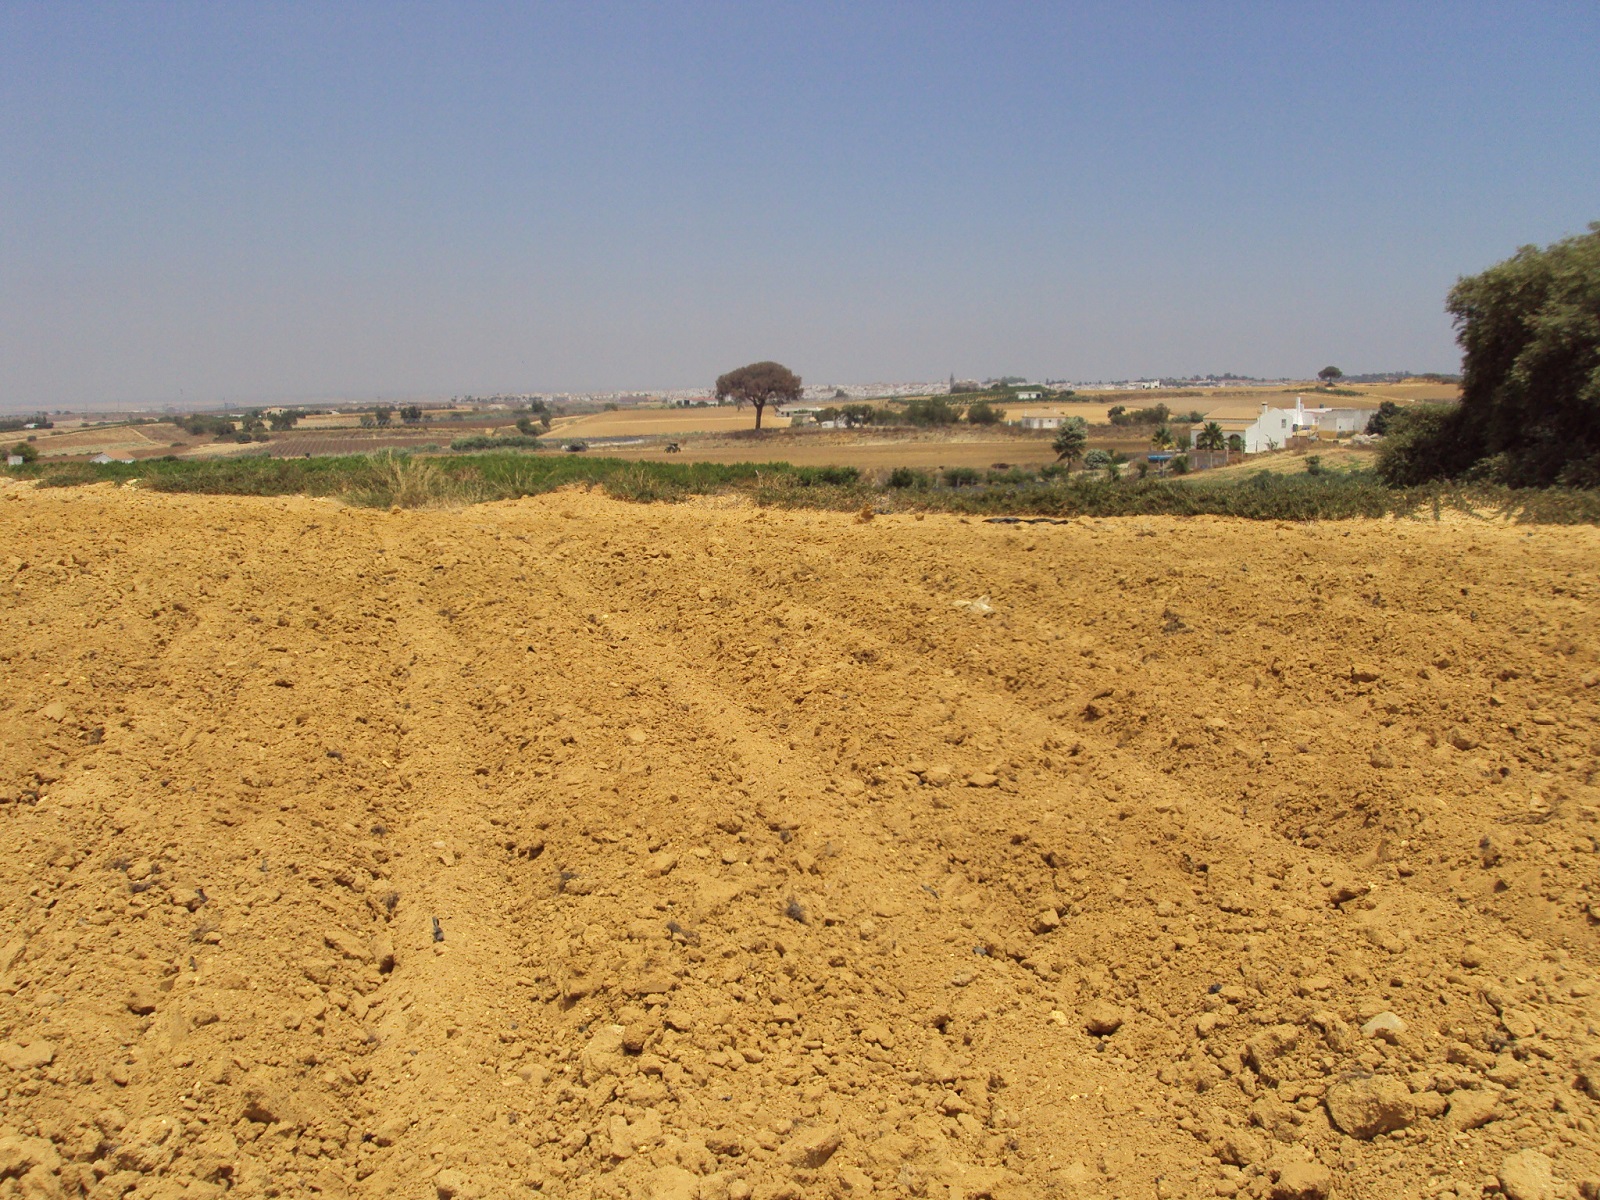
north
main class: Cropland
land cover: Strawberries
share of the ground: > 75 %
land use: Agriculture (excluding fallow land and kitchen gardens)
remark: Harvested field
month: June
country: ES
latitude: 37.2490
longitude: -6.8454
